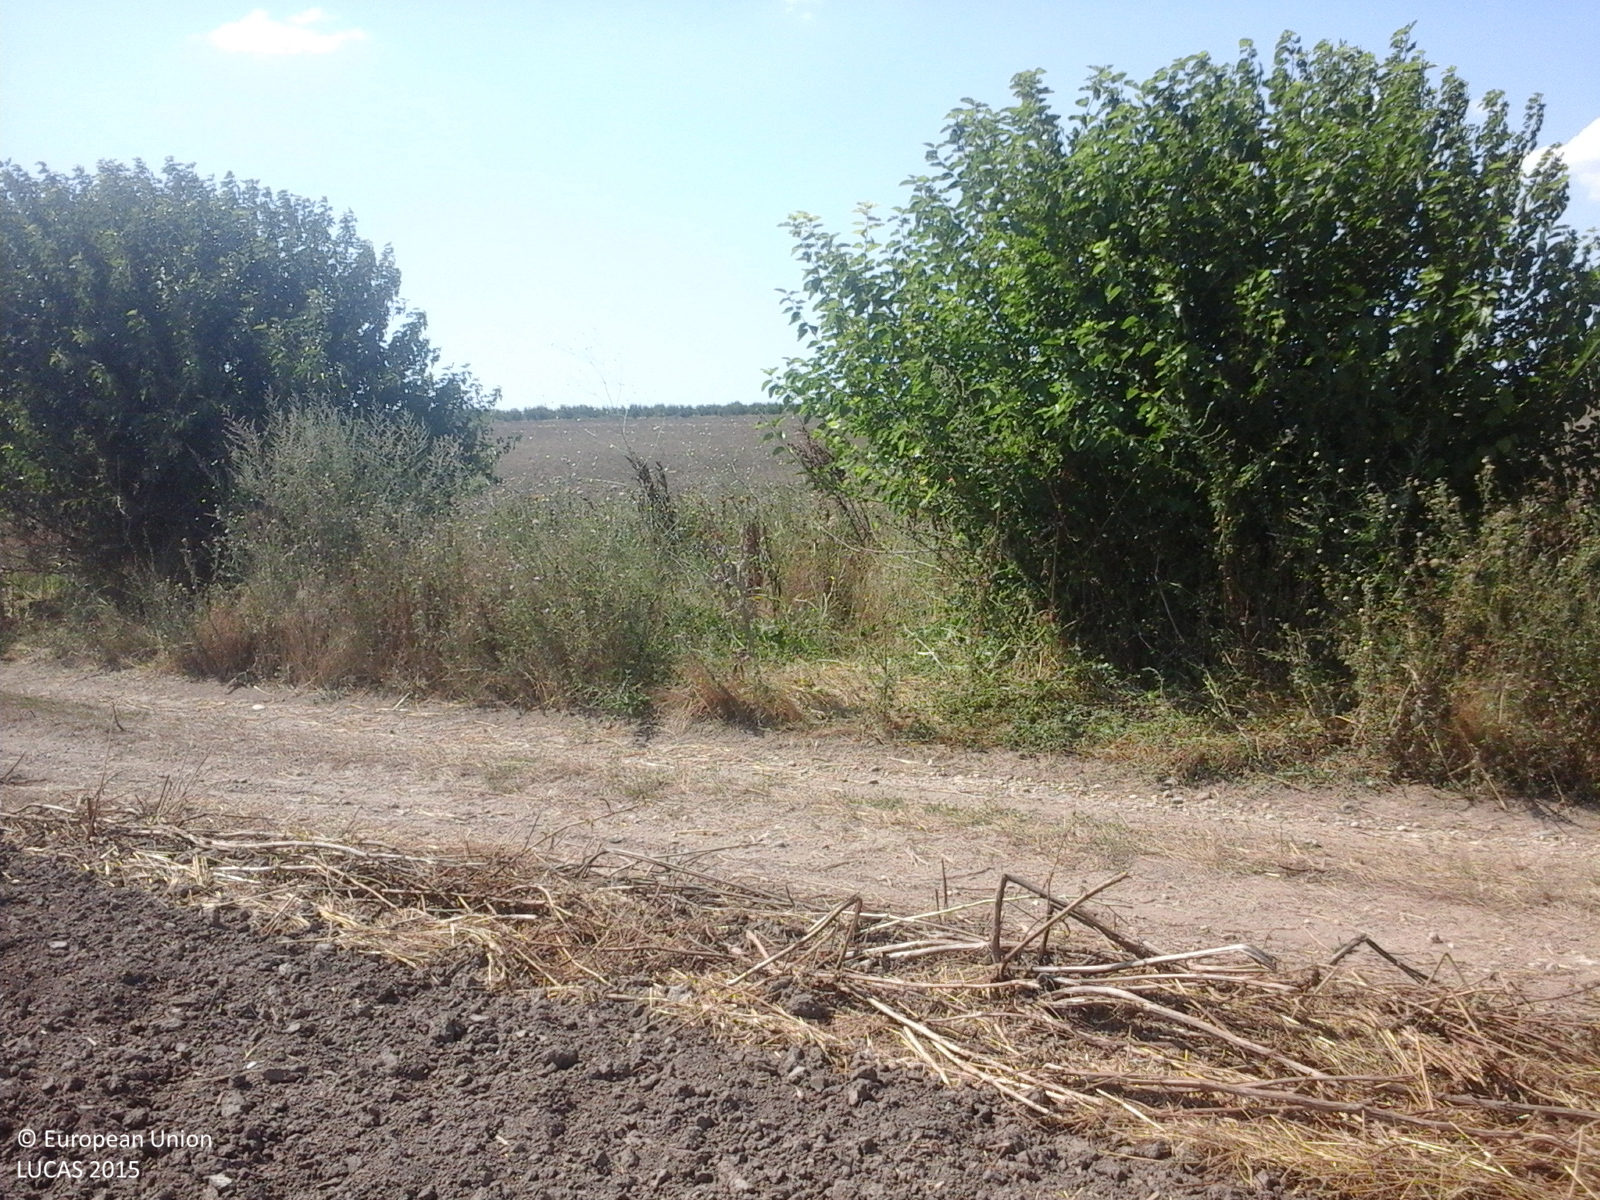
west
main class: Cropland
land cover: Rape and turnip rape
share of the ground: < 10 %
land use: Agriculture (excluding fallow land and kitchen gardens)
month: August
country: RO
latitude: 44.5549
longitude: 28.0747
